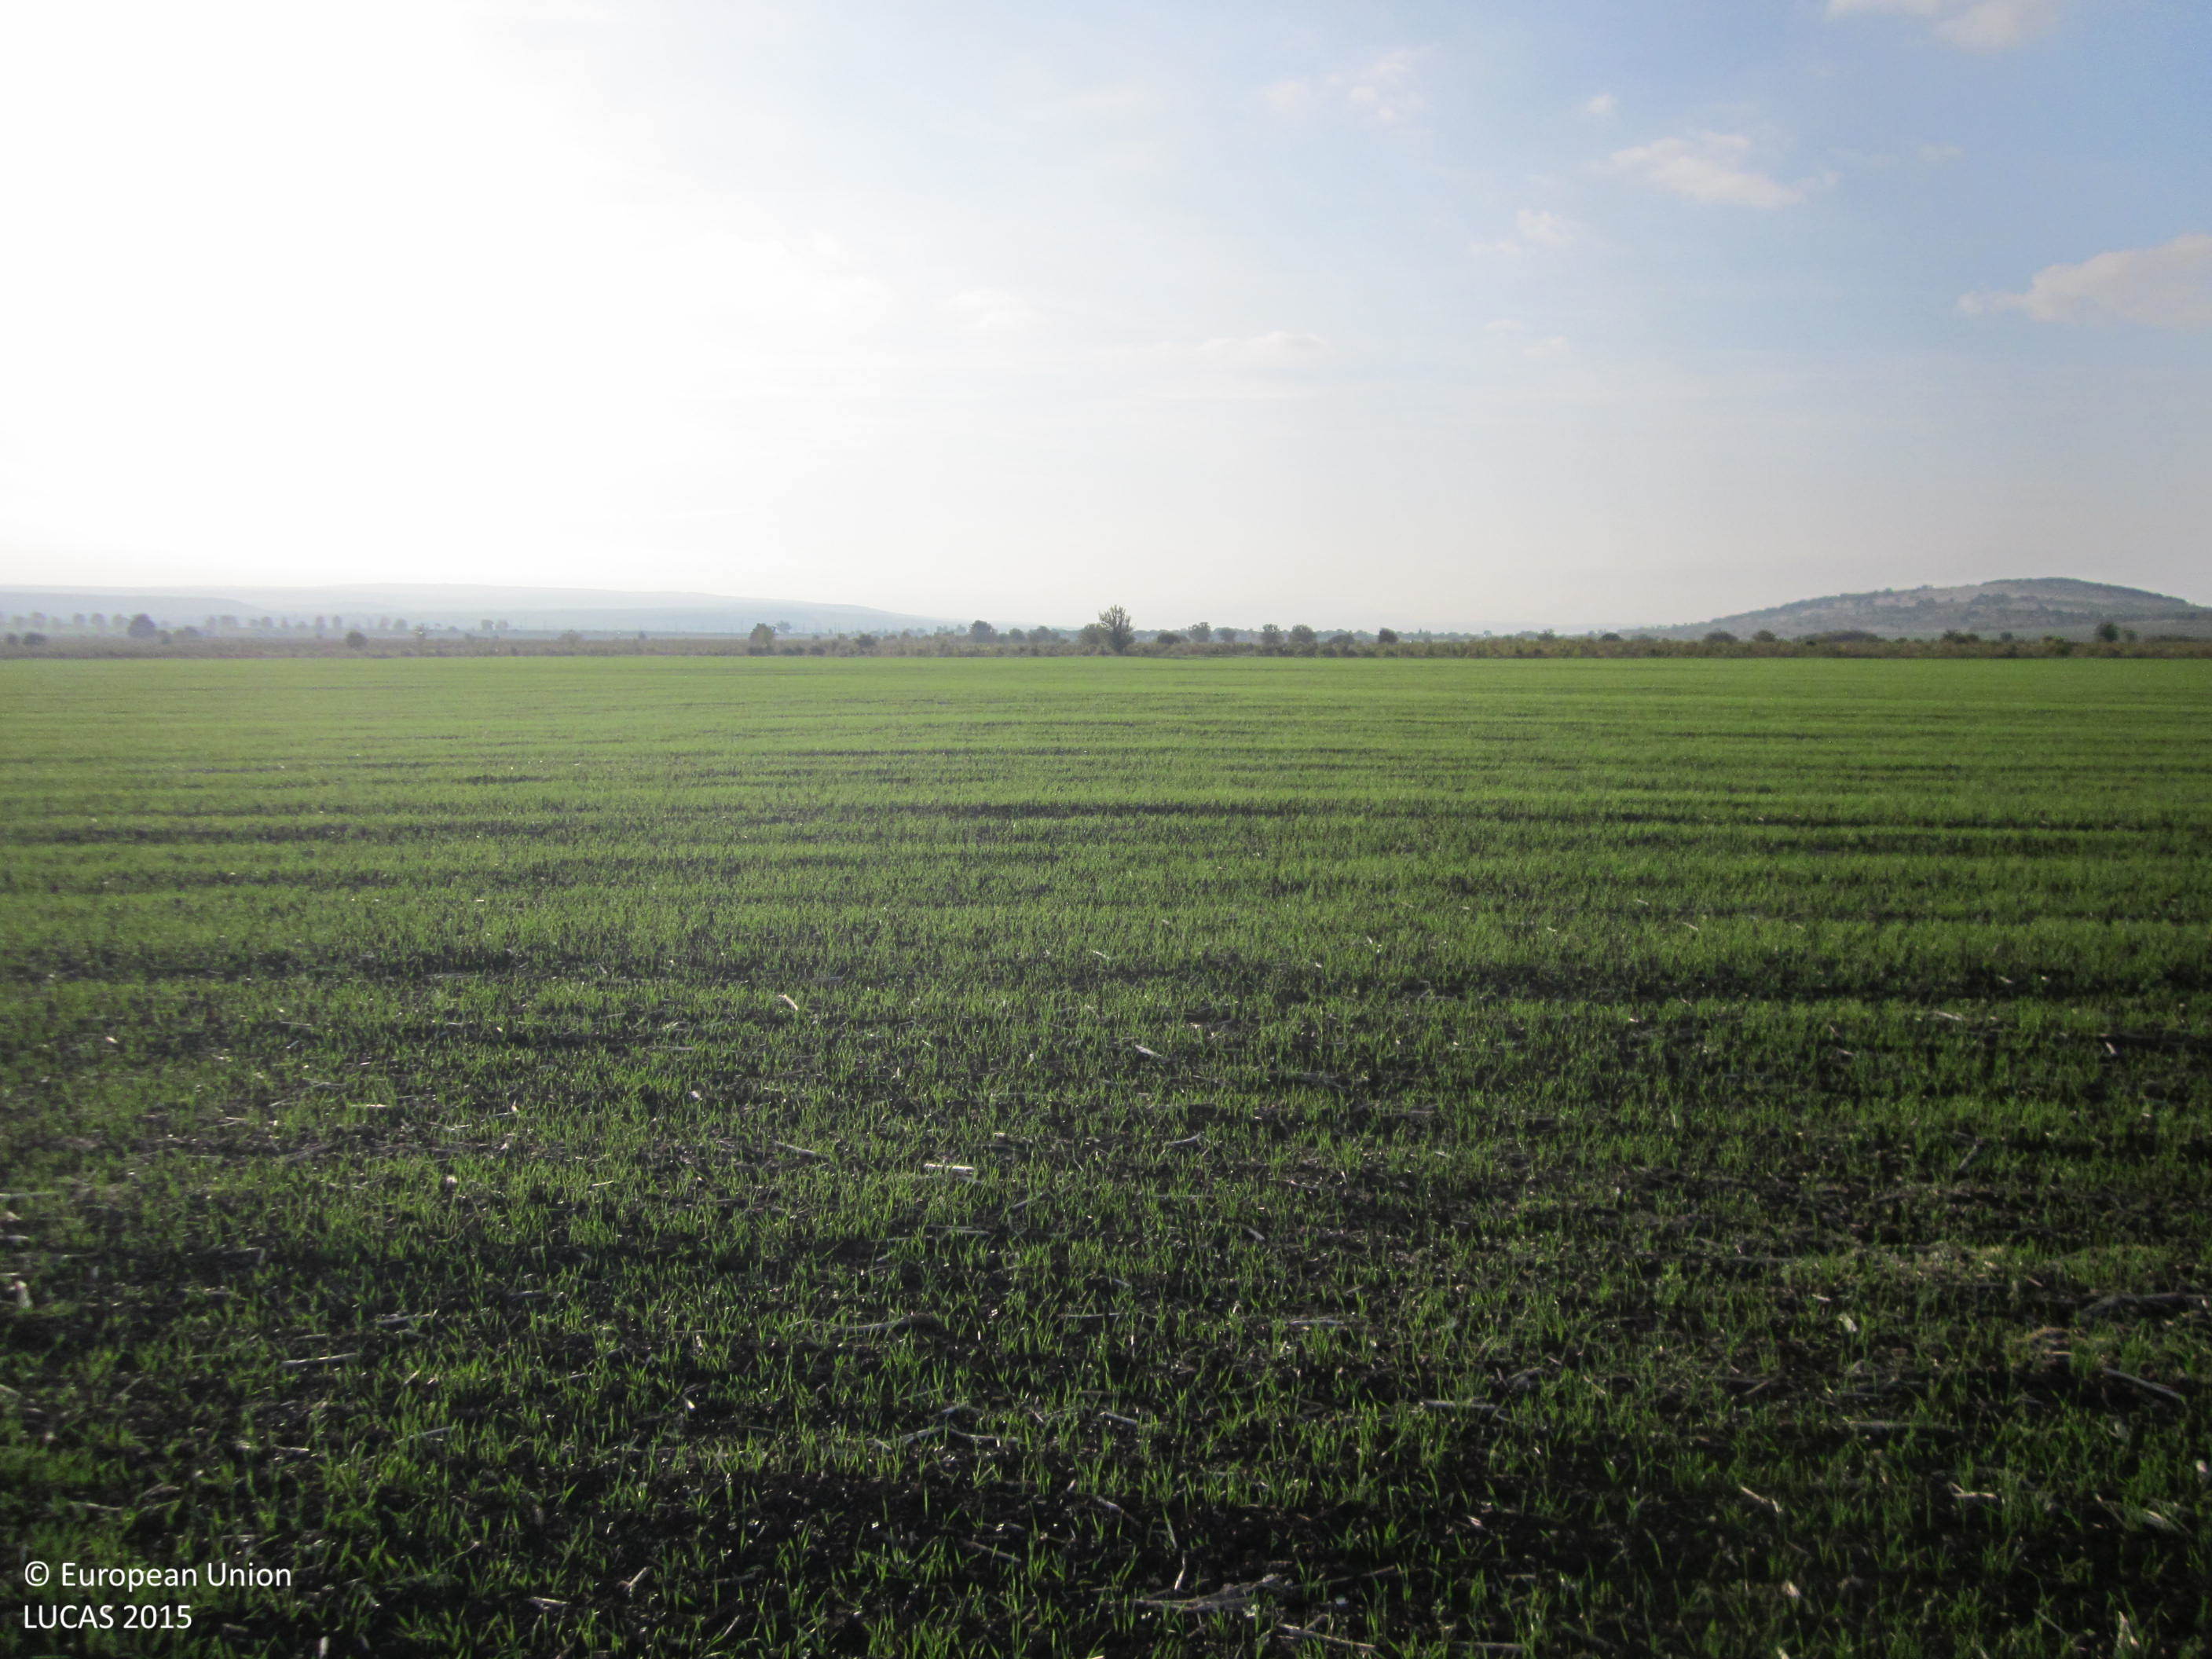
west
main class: Cropland
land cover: Common wheat
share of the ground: 25 - 50 %
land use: Agriculture (excluding fallow land and kitchen gardens)
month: October
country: BG
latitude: 42.7274
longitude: 26.9228
